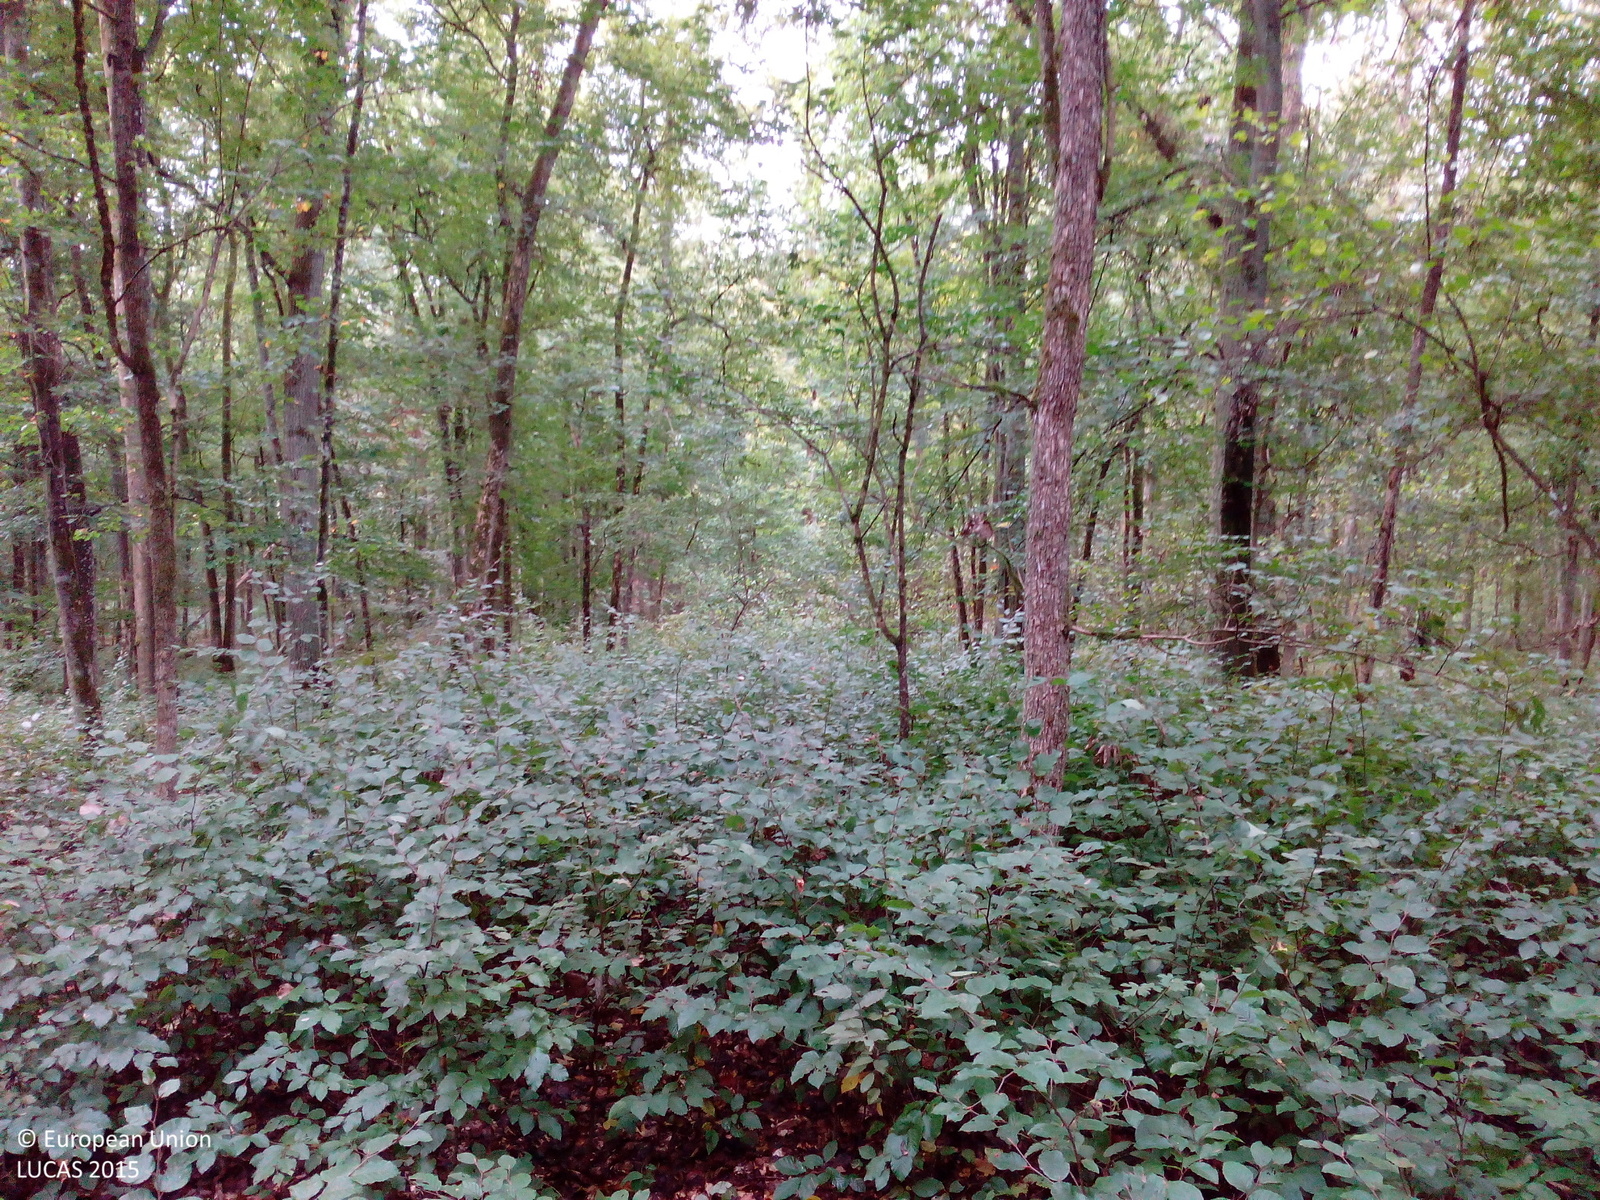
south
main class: Woodland
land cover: Broadleaved woodland
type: acidophilous oak and oak-birch forest
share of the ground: > 75 %
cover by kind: broadleaved forest trees 90 %, shrubs 5 %, unconsolidated bare surface 5 %
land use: Forestry
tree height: > 5 m
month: September
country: DE
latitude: 50.0044
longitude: 9.9024
